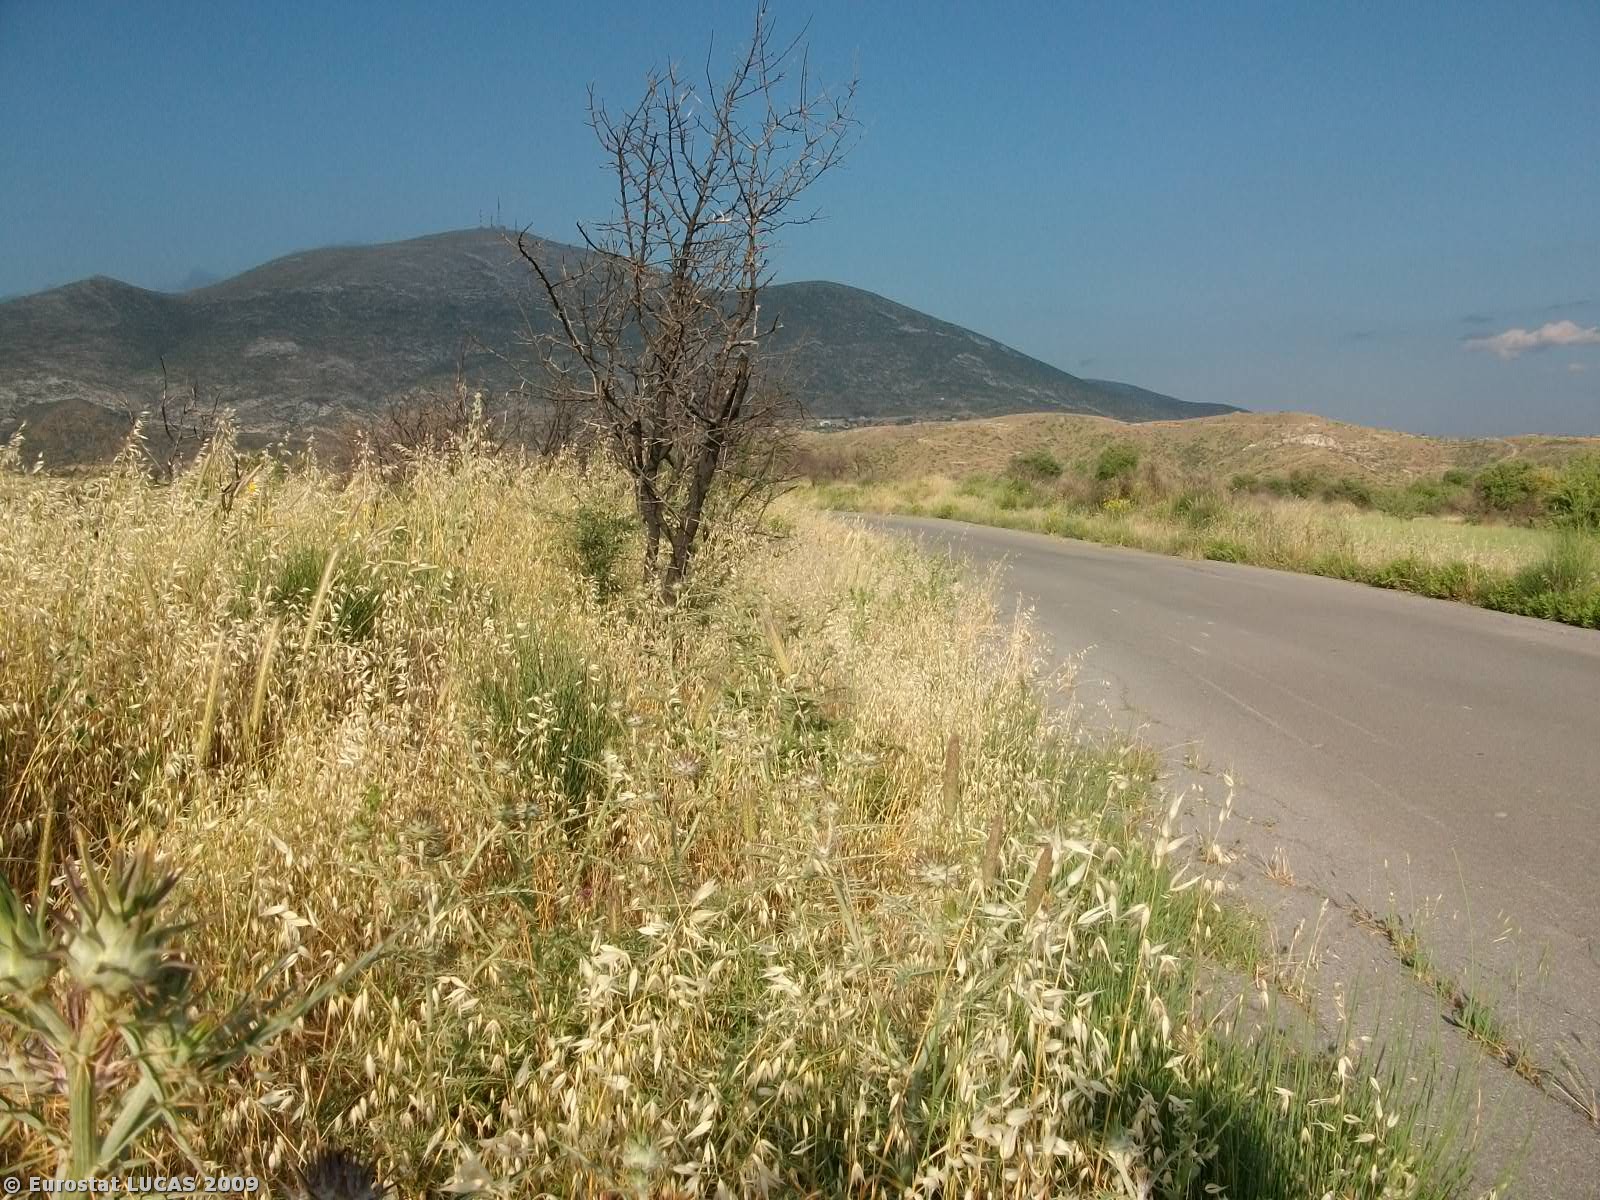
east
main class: Grassland
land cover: Grassland with sparse tree/shrub cover
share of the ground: 50 - 75 %
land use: Unused
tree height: < 5 m
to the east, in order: Grassland with sparse tree/shrub cover; Paved roads, cycling and walking lanes; Grassland with sparse tree/shrub cover; Barley
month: June
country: GR
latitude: 37.3429
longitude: 22.2058
